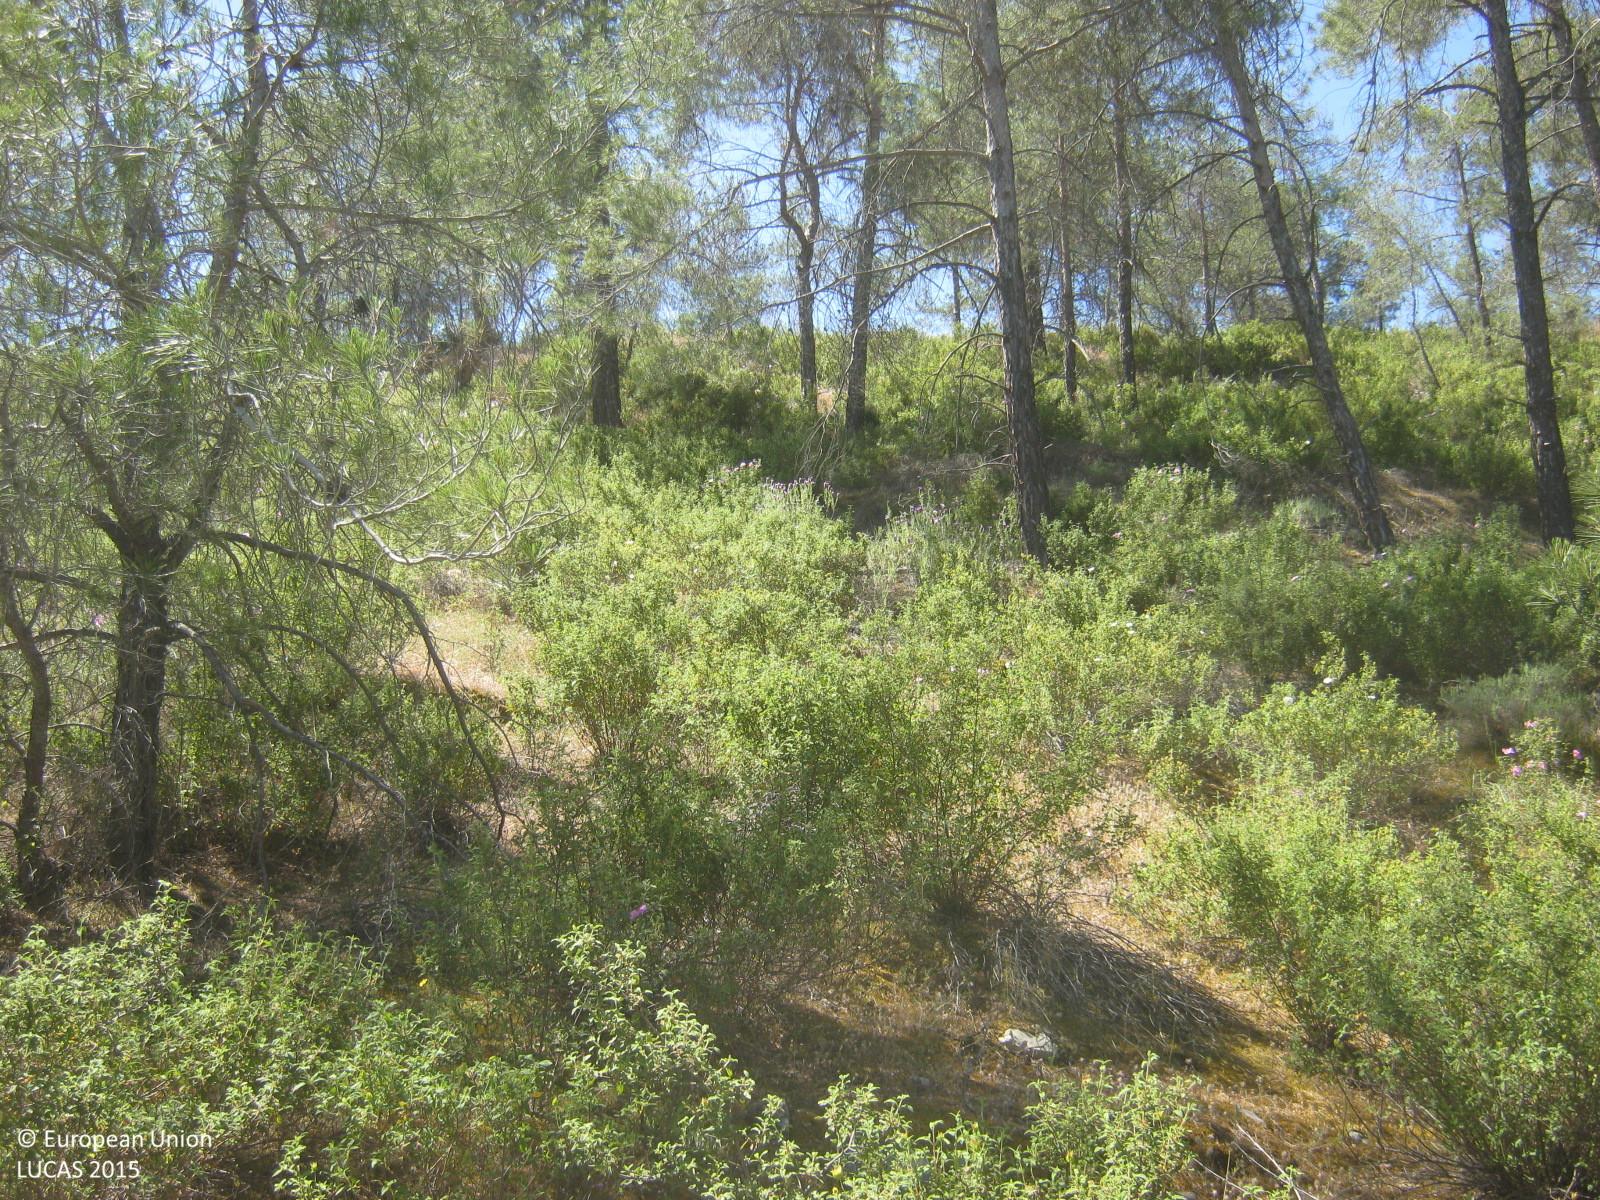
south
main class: Woodland
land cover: Pine dominated coniferous woodland
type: coniferous forest of the mediterranean region
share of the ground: > 75 %
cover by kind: coniferous forest trees 75 %, shrubs 10 %, herbaceous plants 10 %, unconsolidated bare surface 5 %
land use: Forestry
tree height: > 5 m
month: May
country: CY
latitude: 34.9989
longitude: 33.2245
